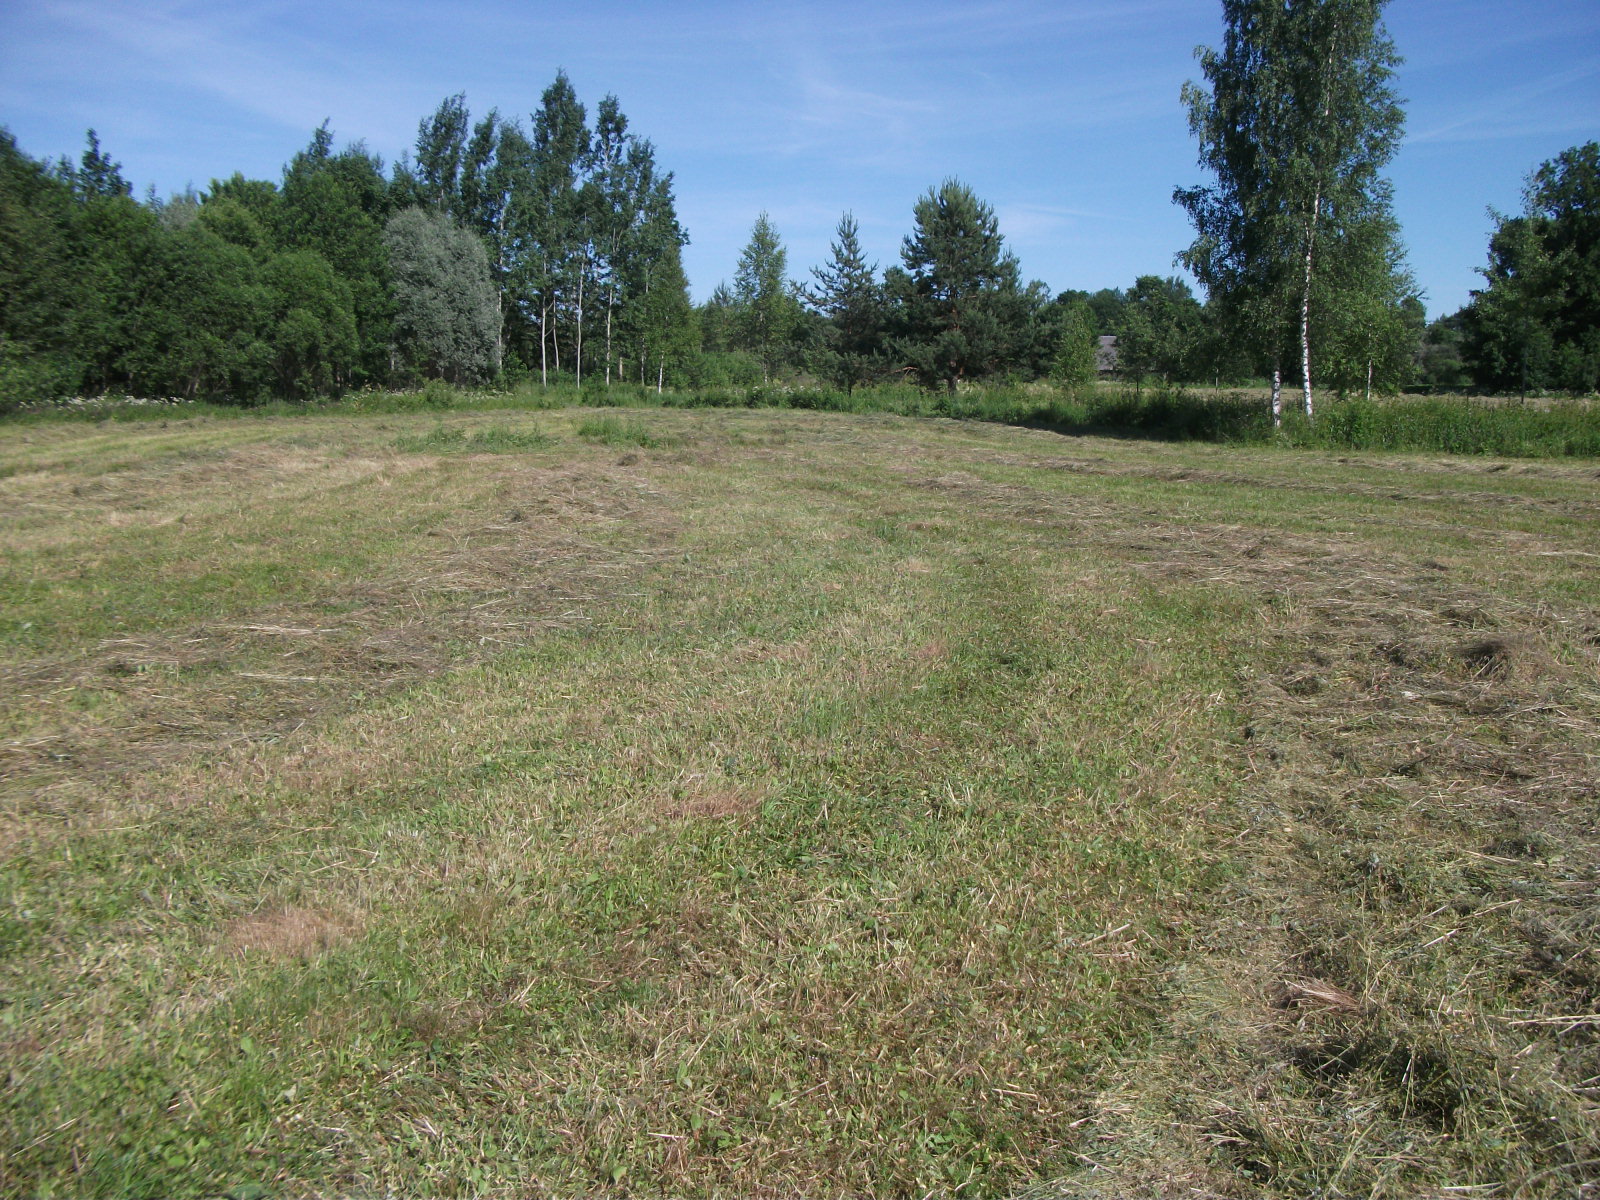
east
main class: Grassland
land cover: Grassland without tree/shrub cover
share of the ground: > 75 %
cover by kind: herbaceous plants 100 %
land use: Agriculture (excluding fallow land and kitchen gardens)
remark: Harvested field
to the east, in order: Grassland without tree/shrub cover; Broadleaved woodland; Spruce dominated mixed woodland; Grassland without tree/shrub cover; Tracks; Grassland without tree/shrub cover
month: July
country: LV
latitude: 56.7477
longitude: 26.3471
